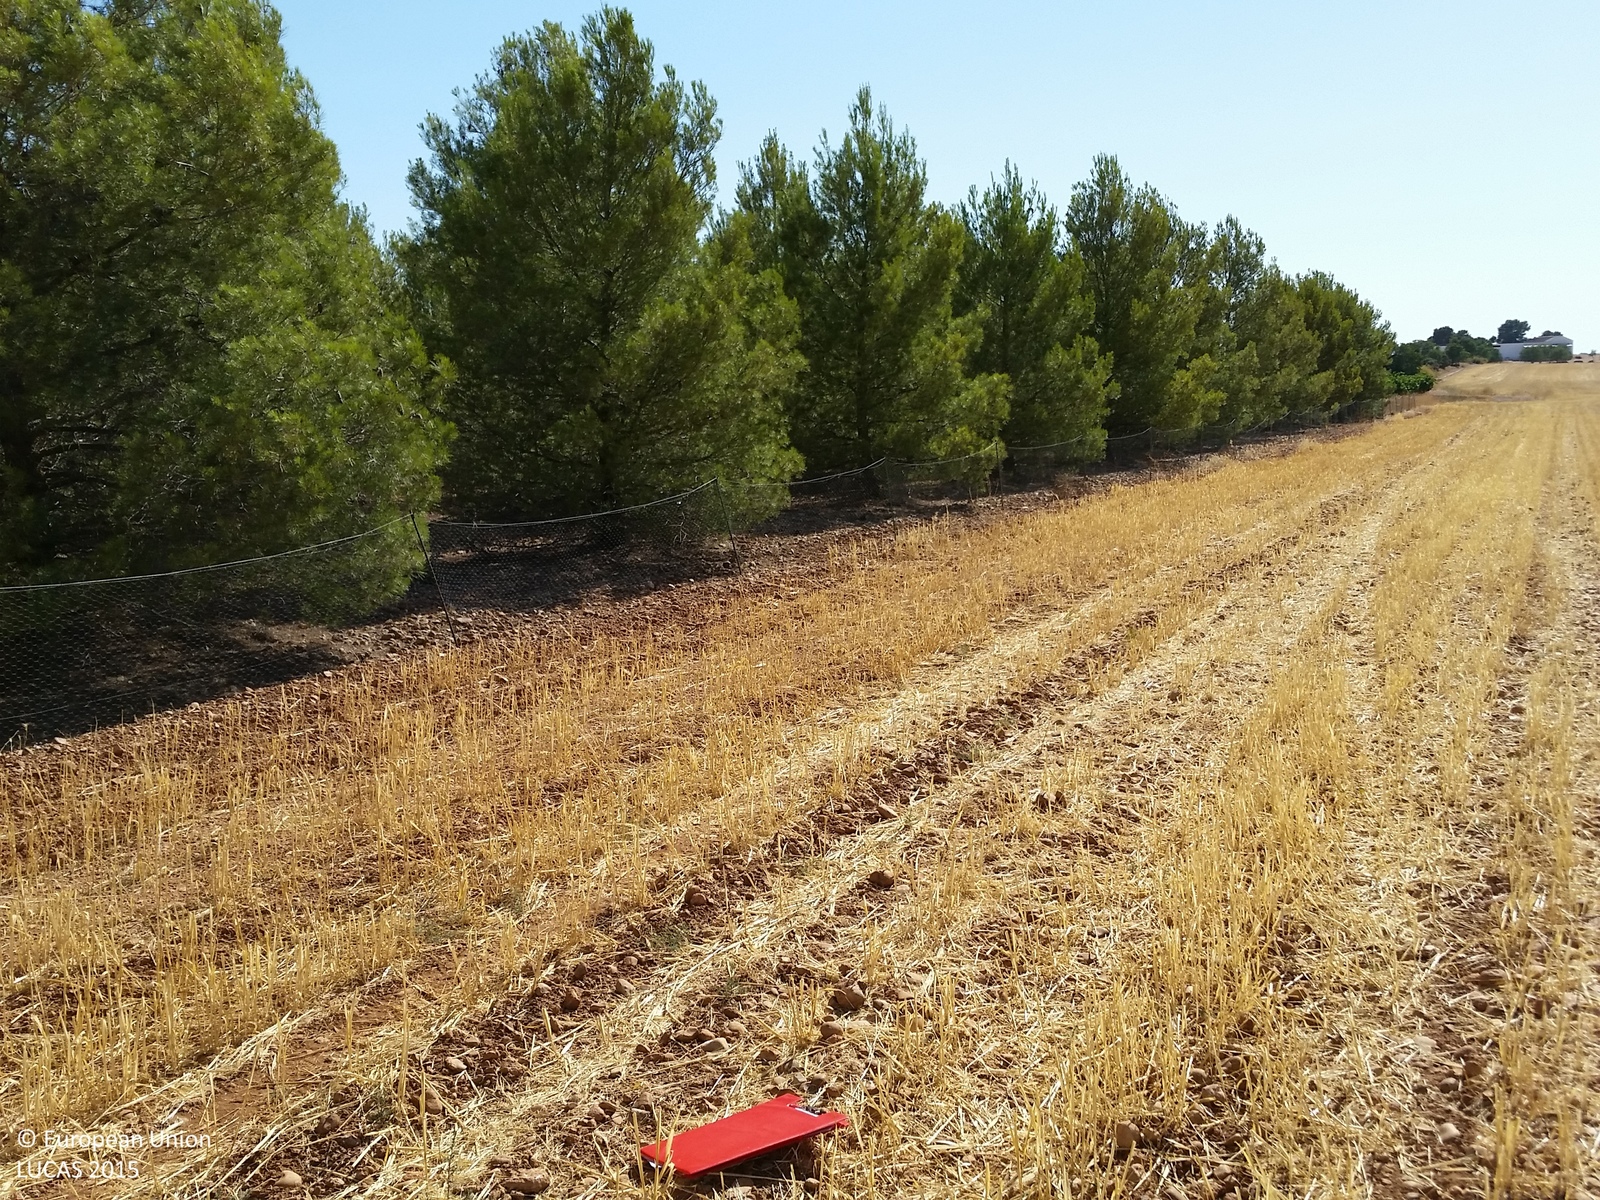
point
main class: Cropland
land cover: Barley
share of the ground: < 10 %
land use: Agriculture (excluding fallow land and kitchen gardens)
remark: Harvested field
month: July
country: ES
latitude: 39.2197
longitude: -2.6932
